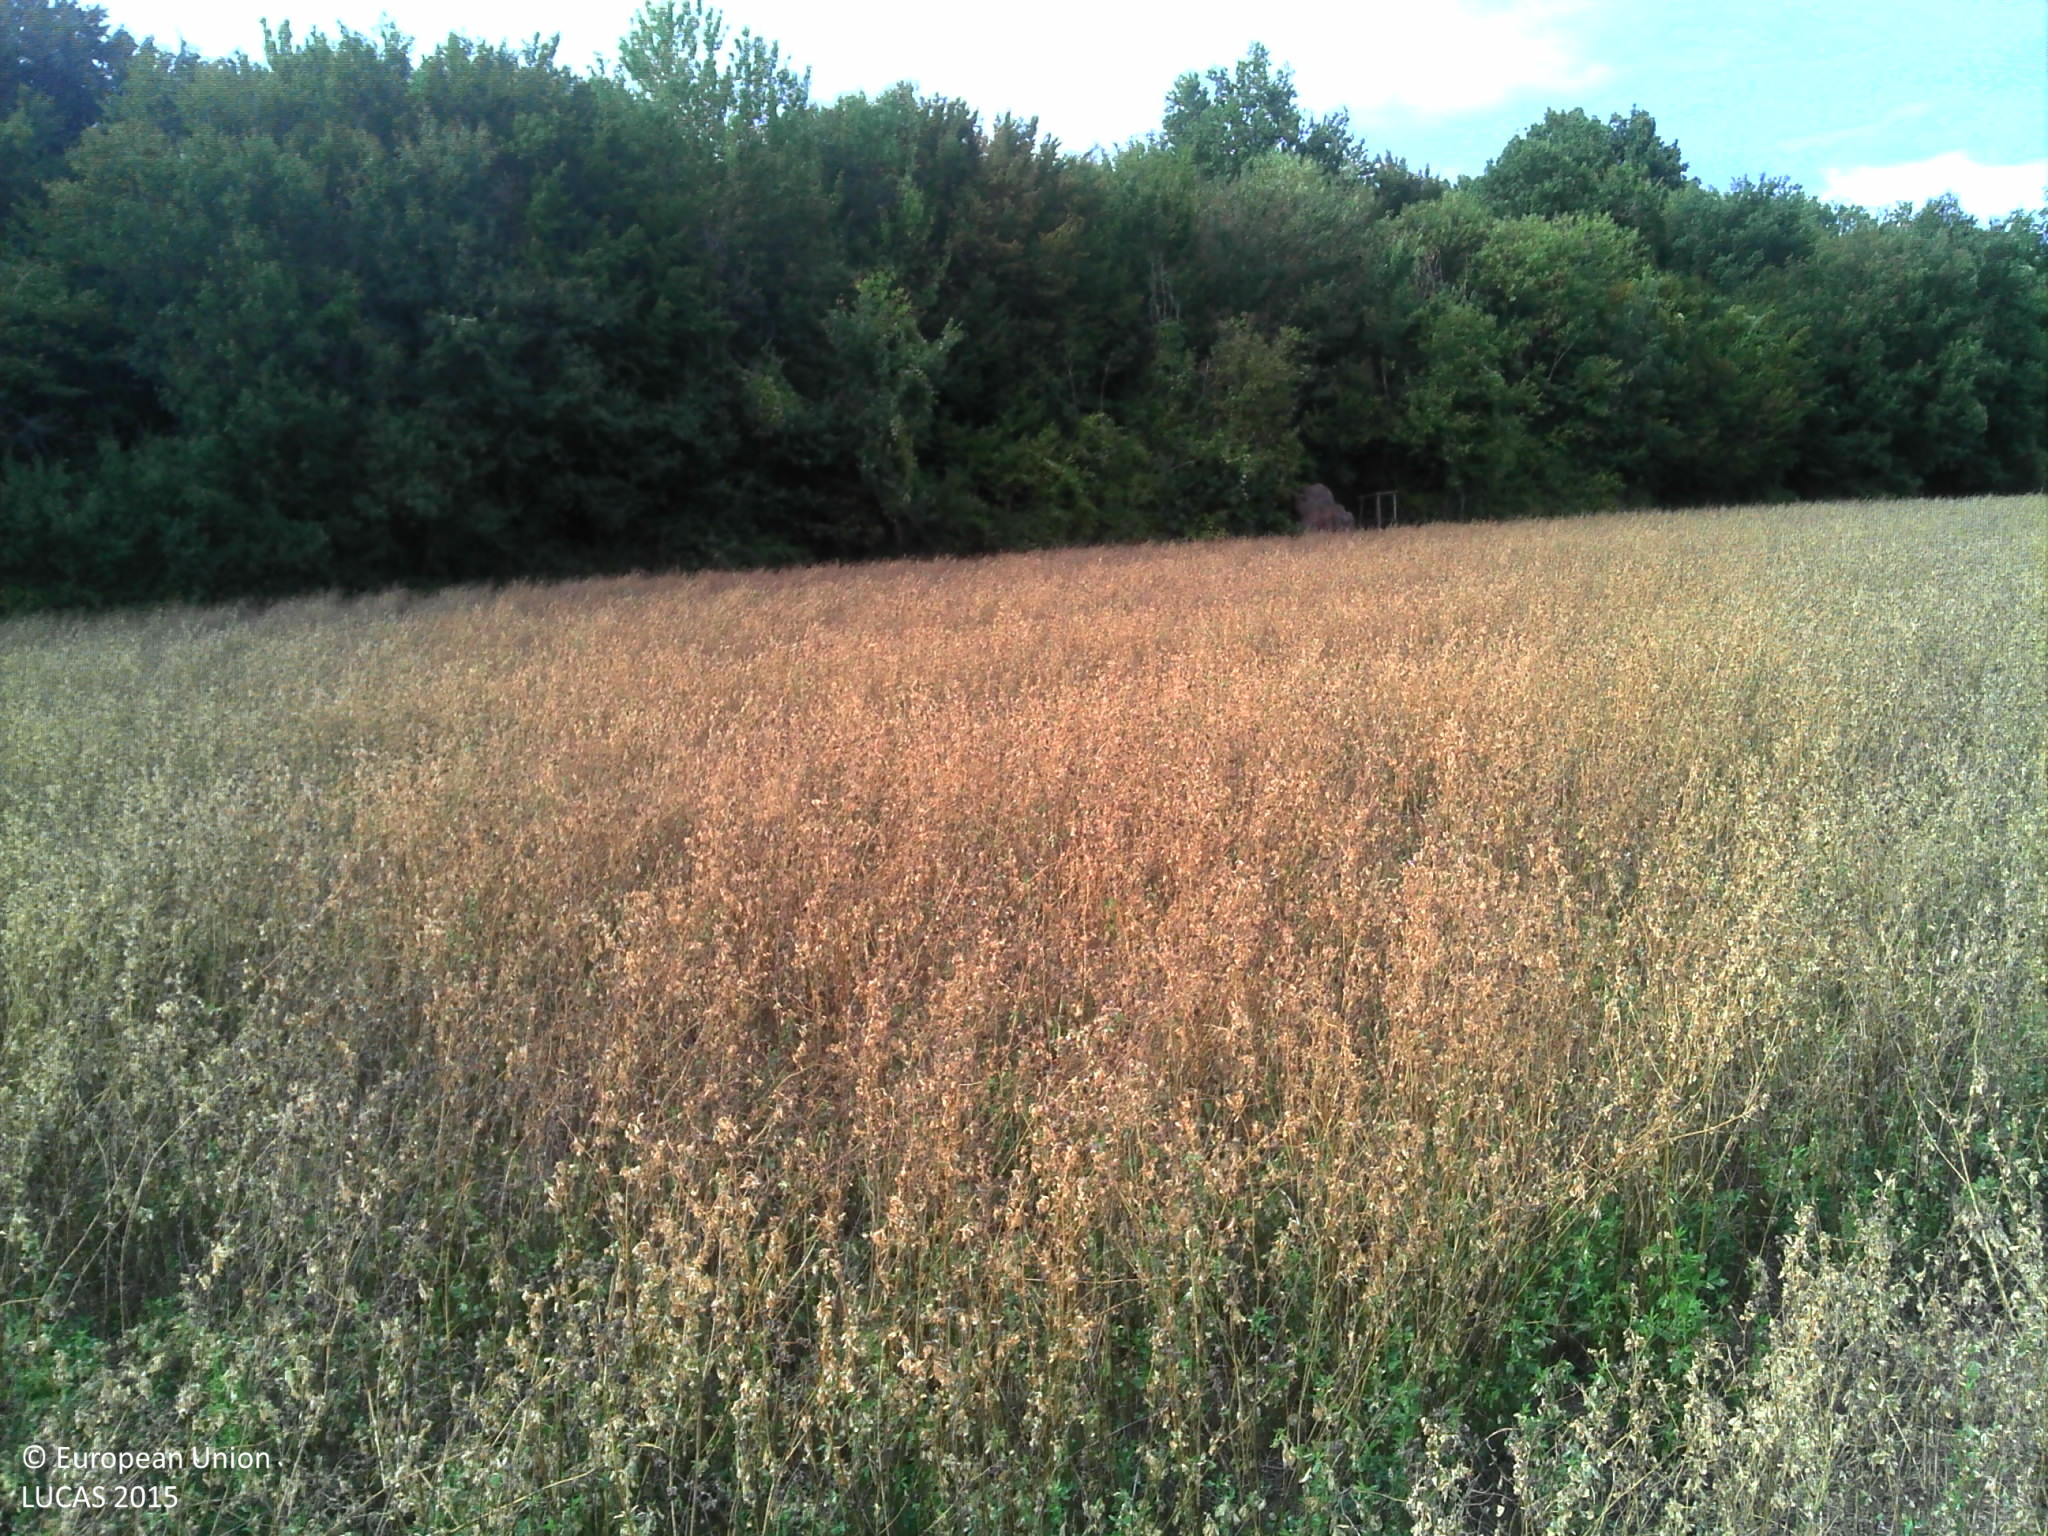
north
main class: Cropland
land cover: Lucerne
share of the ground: > 75 %
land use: Agriculture (excluding fallow land and kitchen gardens)
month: September
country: FR
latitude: 46.8833
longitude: 1.5243
